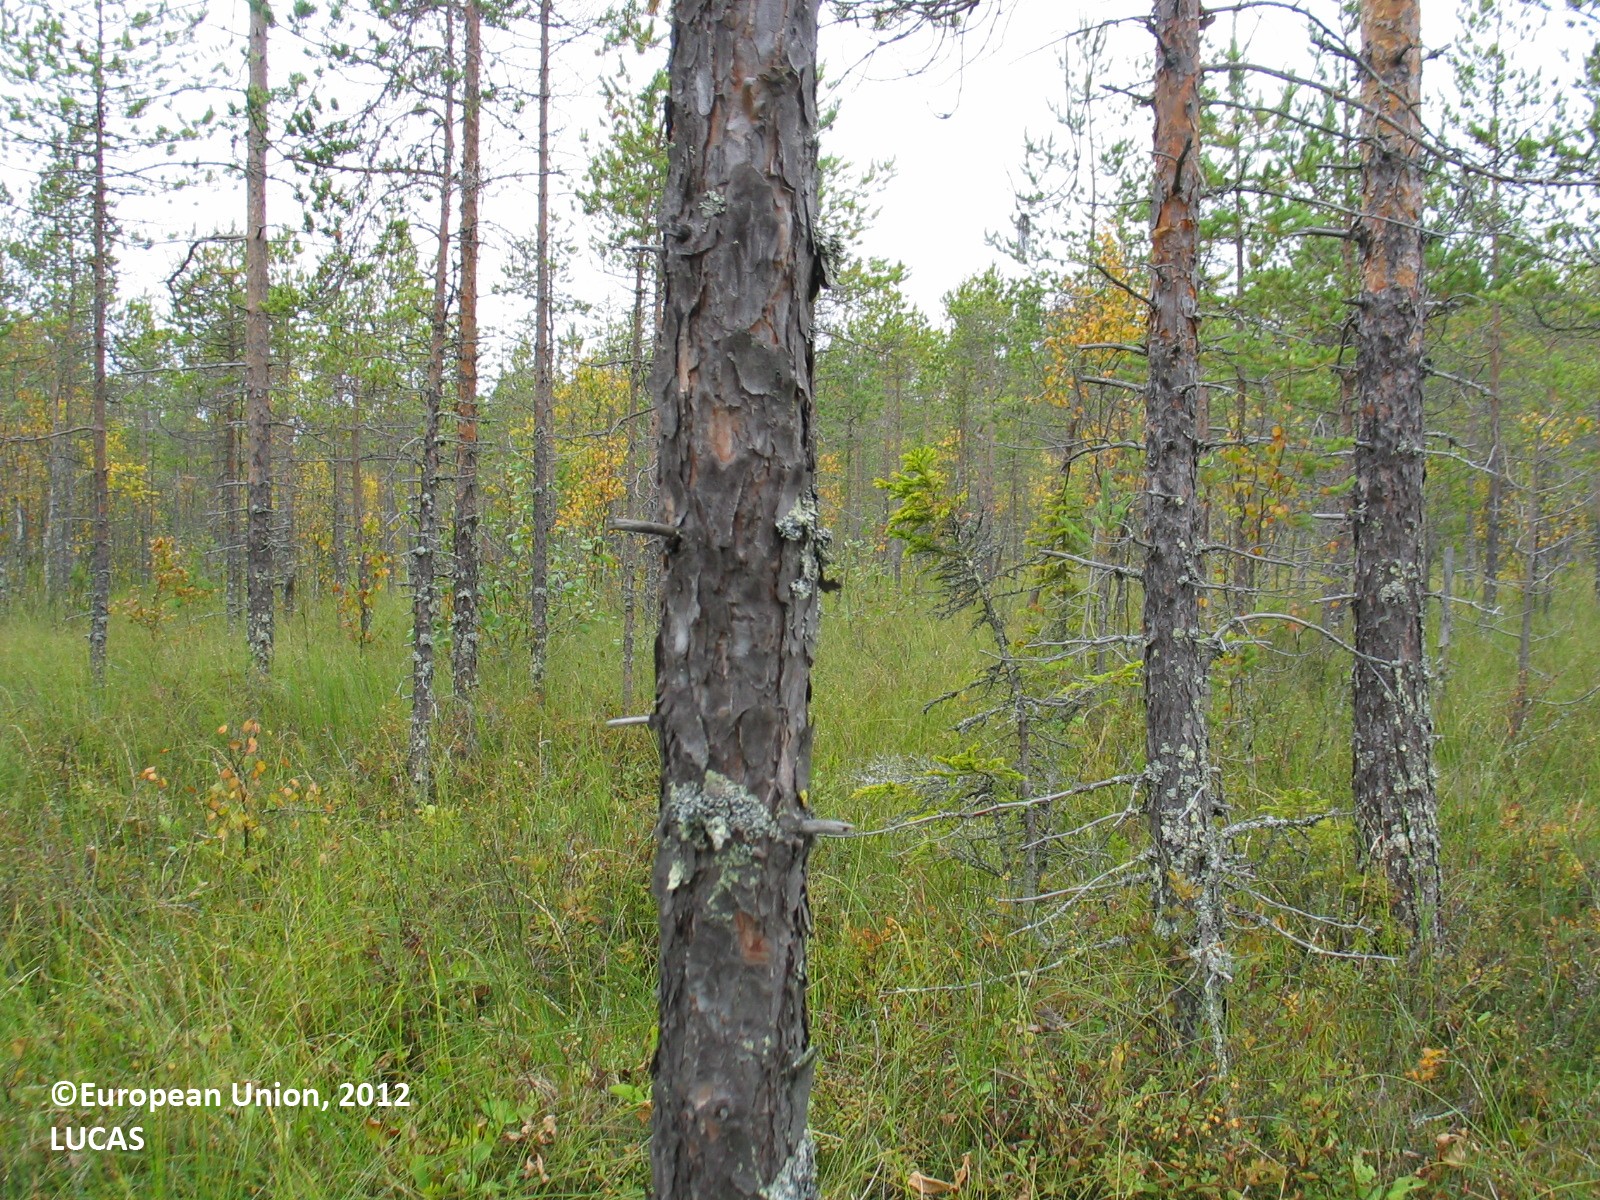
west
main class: Woodland
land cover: Pine dominated coniferous woodland
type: mire and swamp forests
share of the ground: 25 - 50 %
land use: Forestry
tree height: > 5 m
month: September
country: FI
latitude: 65.6053
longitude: 25.1492
